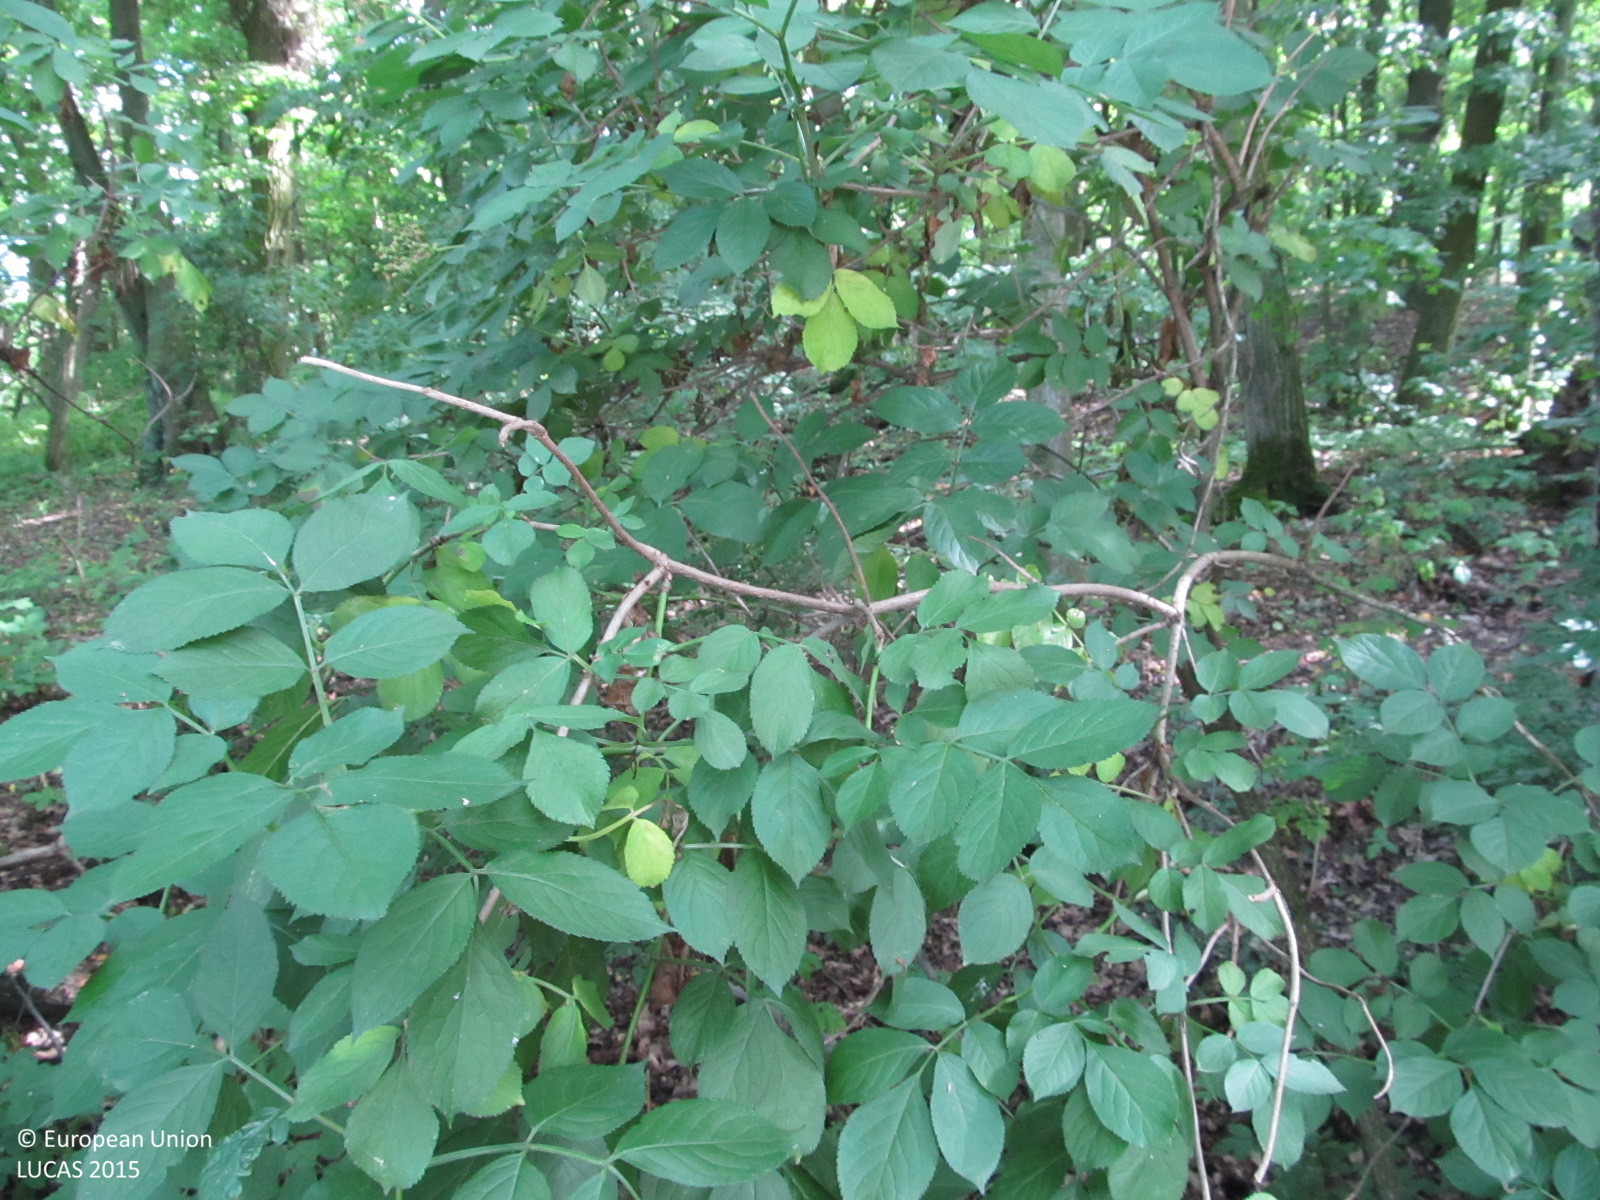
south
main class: Woodland
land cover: Broadleaved woodland
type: hemiboreal forest and nemoral coniferous forest and mixed broadleaved-coniferous forest
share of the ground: > 75 %
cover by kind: broadleaved forest trees 80 %, shrubs 10 %, herbaceous plants 10 %
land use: Forestry
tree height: > 5 m
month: June
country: AT
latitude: 48.5571
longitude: 15.8162
